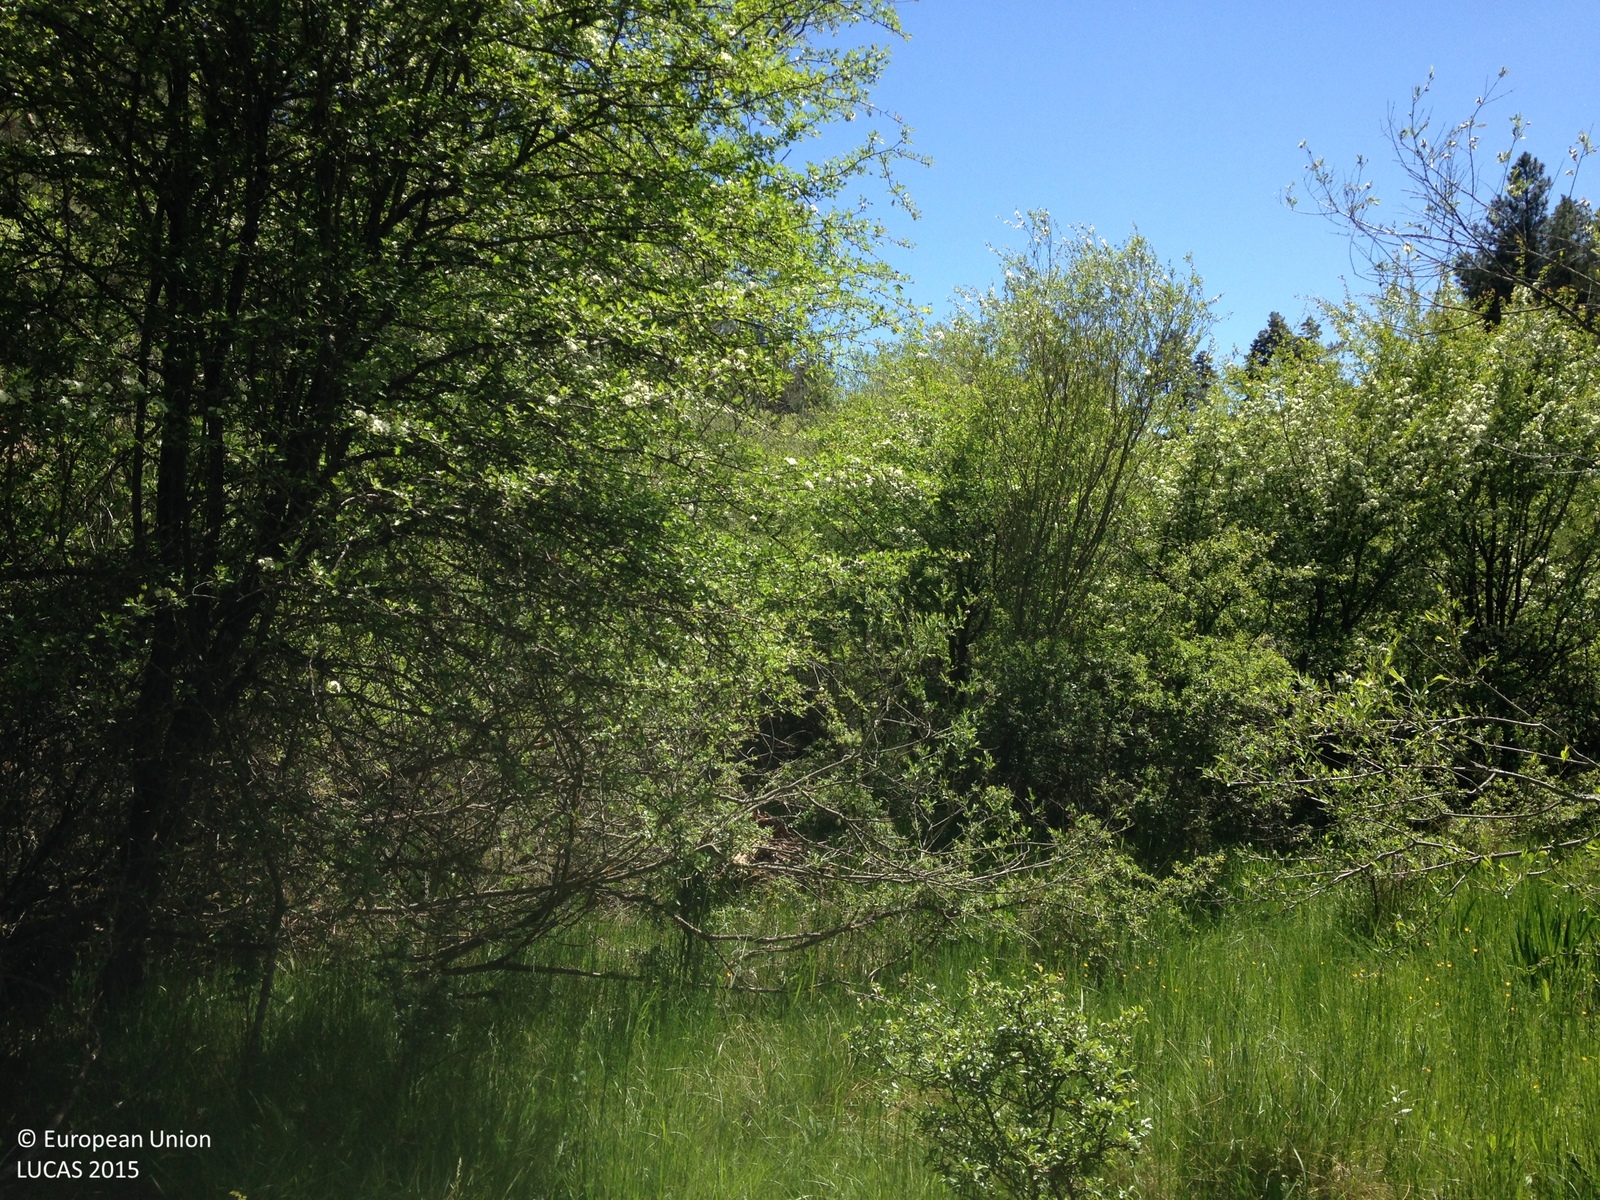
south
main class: Woodland
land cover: Pine dominated coniferous woodland
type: coniferous forest of the mediterranean region
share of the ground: > 75 %
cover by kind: coniferous forest trees 50 %, shrubs 20 %, herbaceous plants 20 %, consolidated bare surface 10 %
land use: Semi-natural and natural areas not in use
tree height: > 5 m
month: May
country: ES
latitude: 40.5680
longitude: -2.0092
